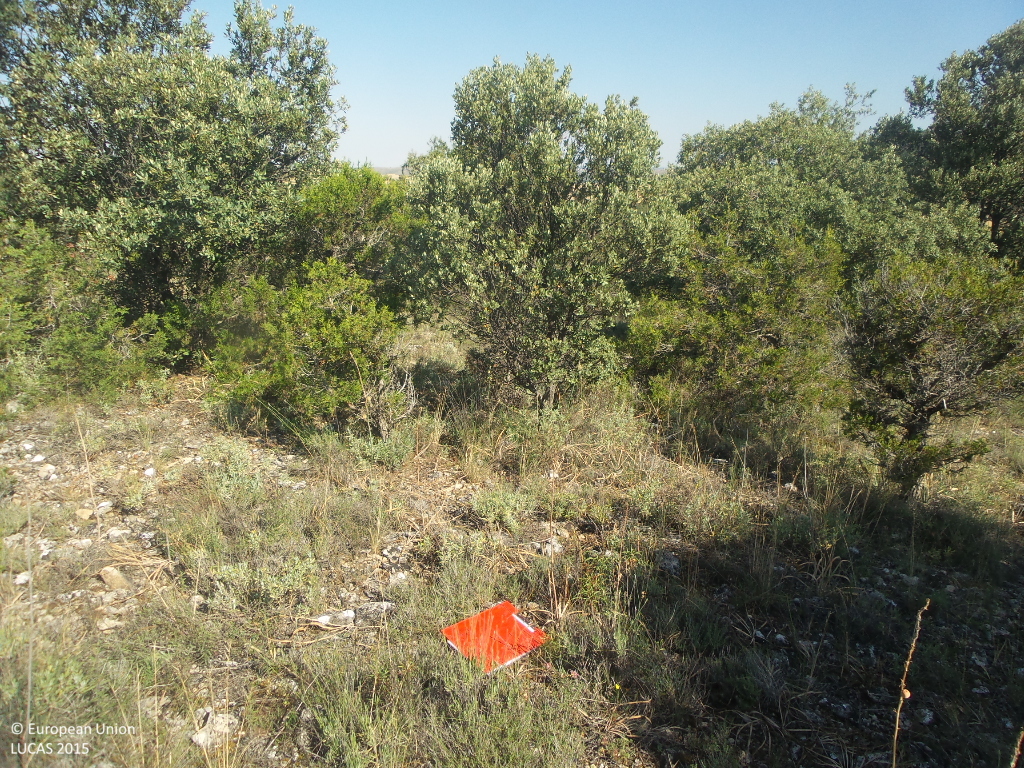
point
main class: Woodland
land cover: Other mixed woodland
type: coniferous forest of the mediterranean region
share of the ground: 50 - 75 %
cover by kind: coniferous forest trees 25 %, broadleaved forest trees 25 %, shrubs 25 %, unconsolidated bare surface 20 %, herbaceous plants 5 %
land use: Semi-natural and natural areas not in use
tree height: < 5 m
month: June
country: ES
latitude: 41.4494
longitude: -2.9804
